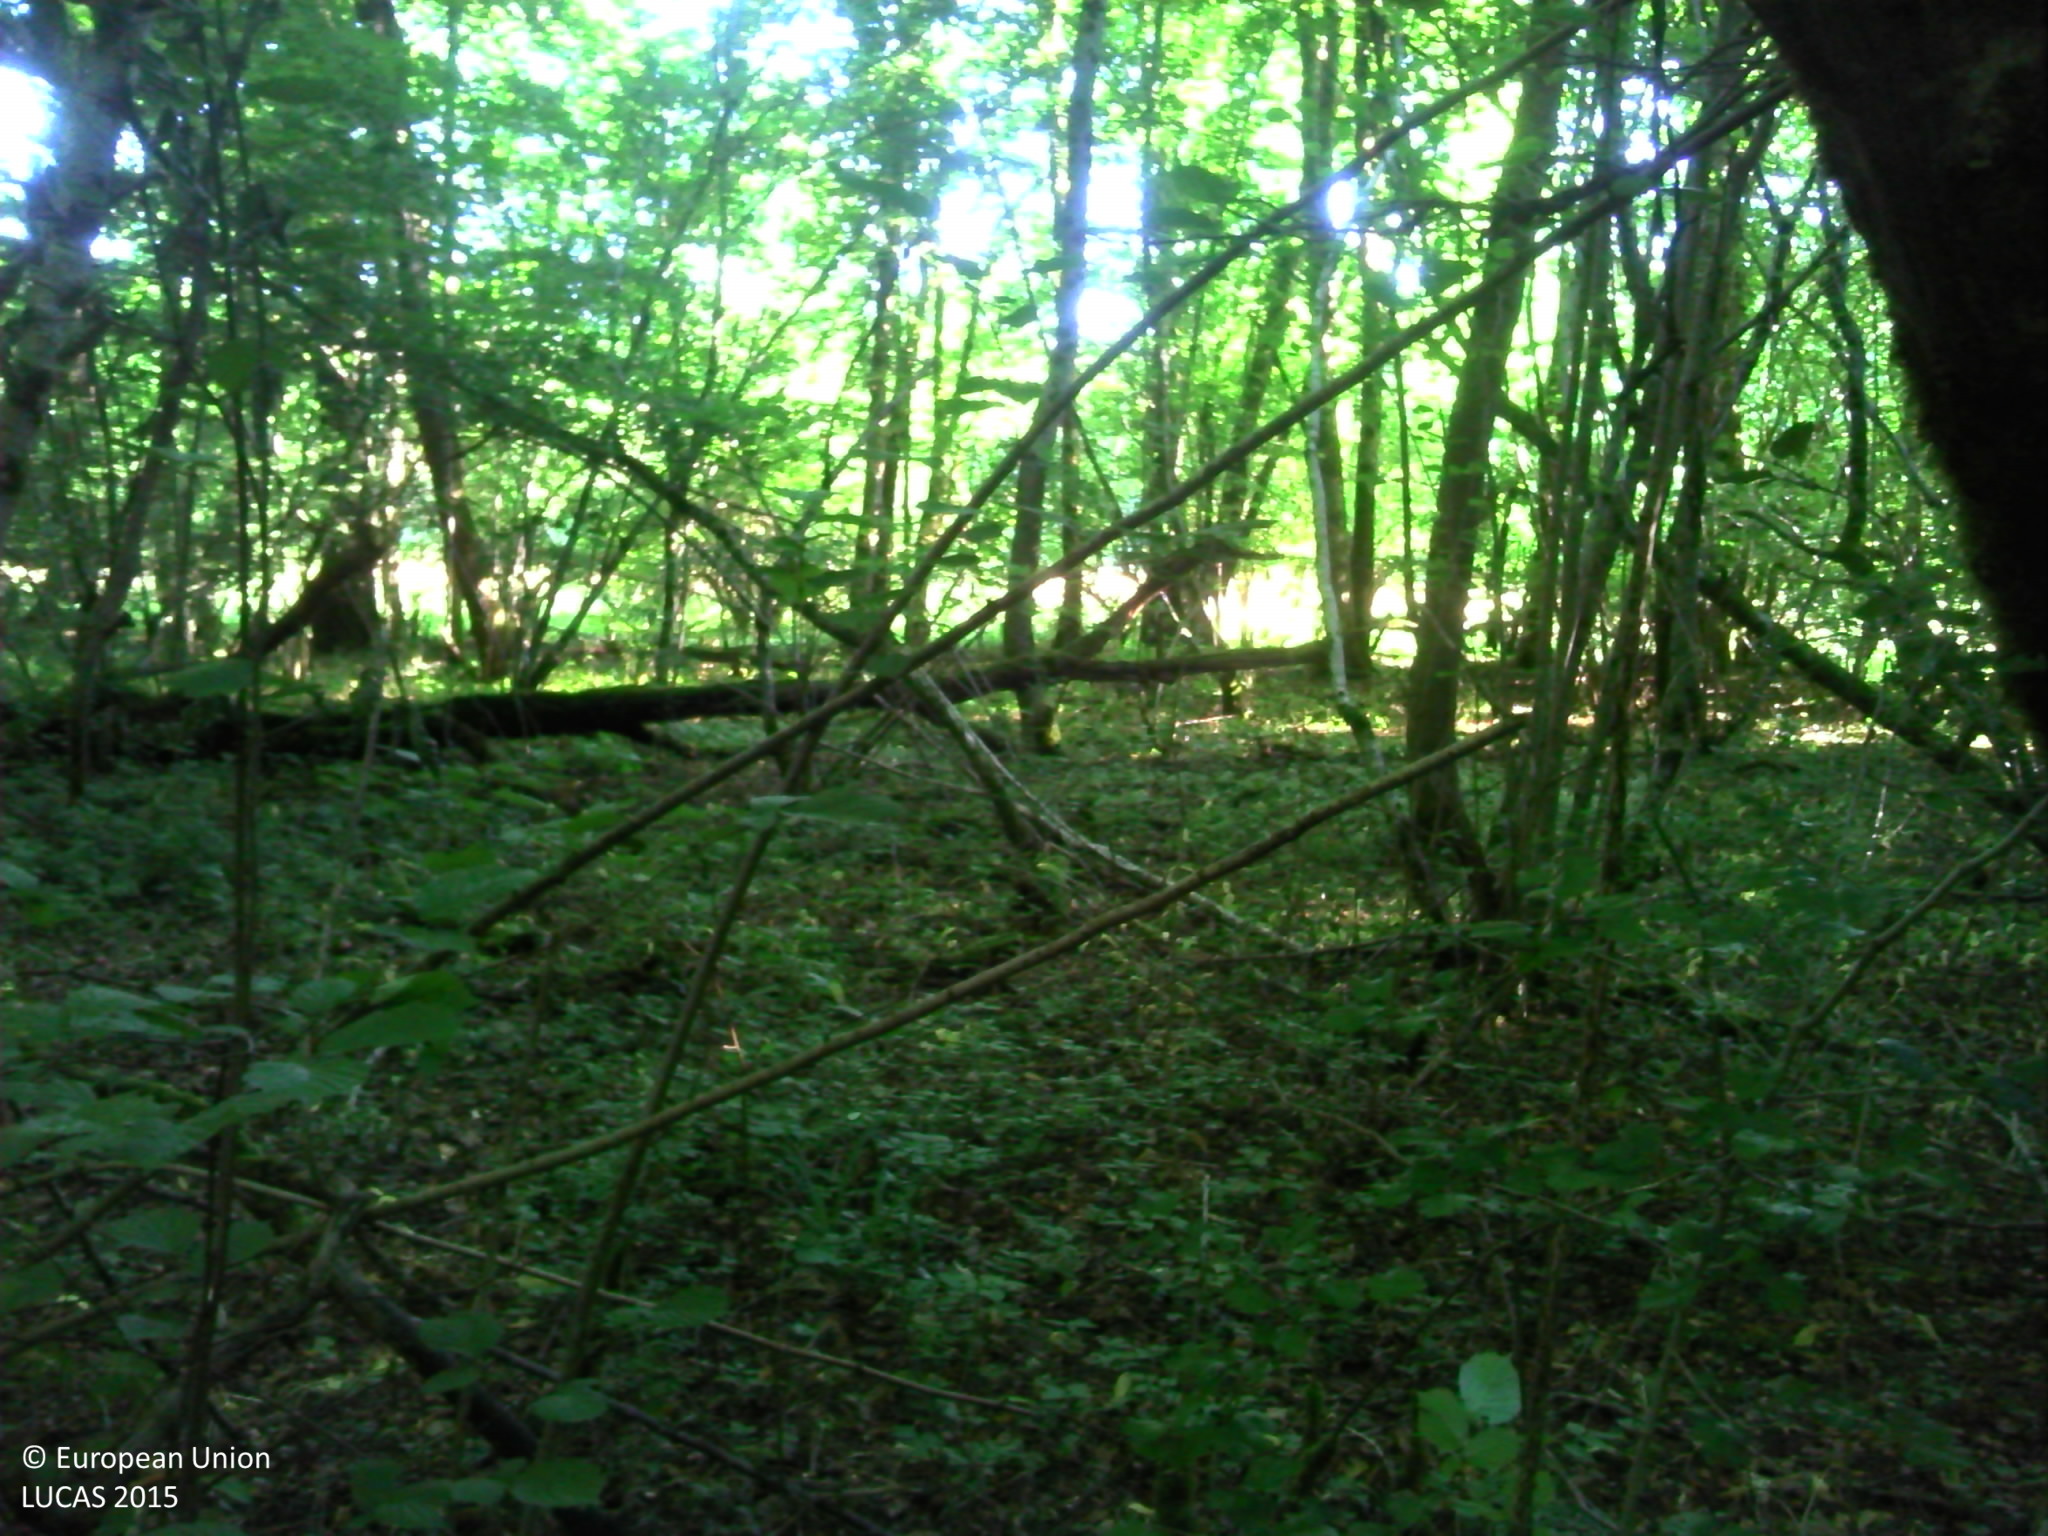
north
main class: Woodland
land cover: Broadleaved woodland
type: mesophytic deciduous forest
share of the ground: > 75 %
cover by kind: broadleaved forest trees 85 %, herbaceous plants 10 %, lichens and mosses 5 %
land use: Forestry
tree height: > 5 m
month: July
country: FR
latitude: 48.9208
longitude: 4.9894
